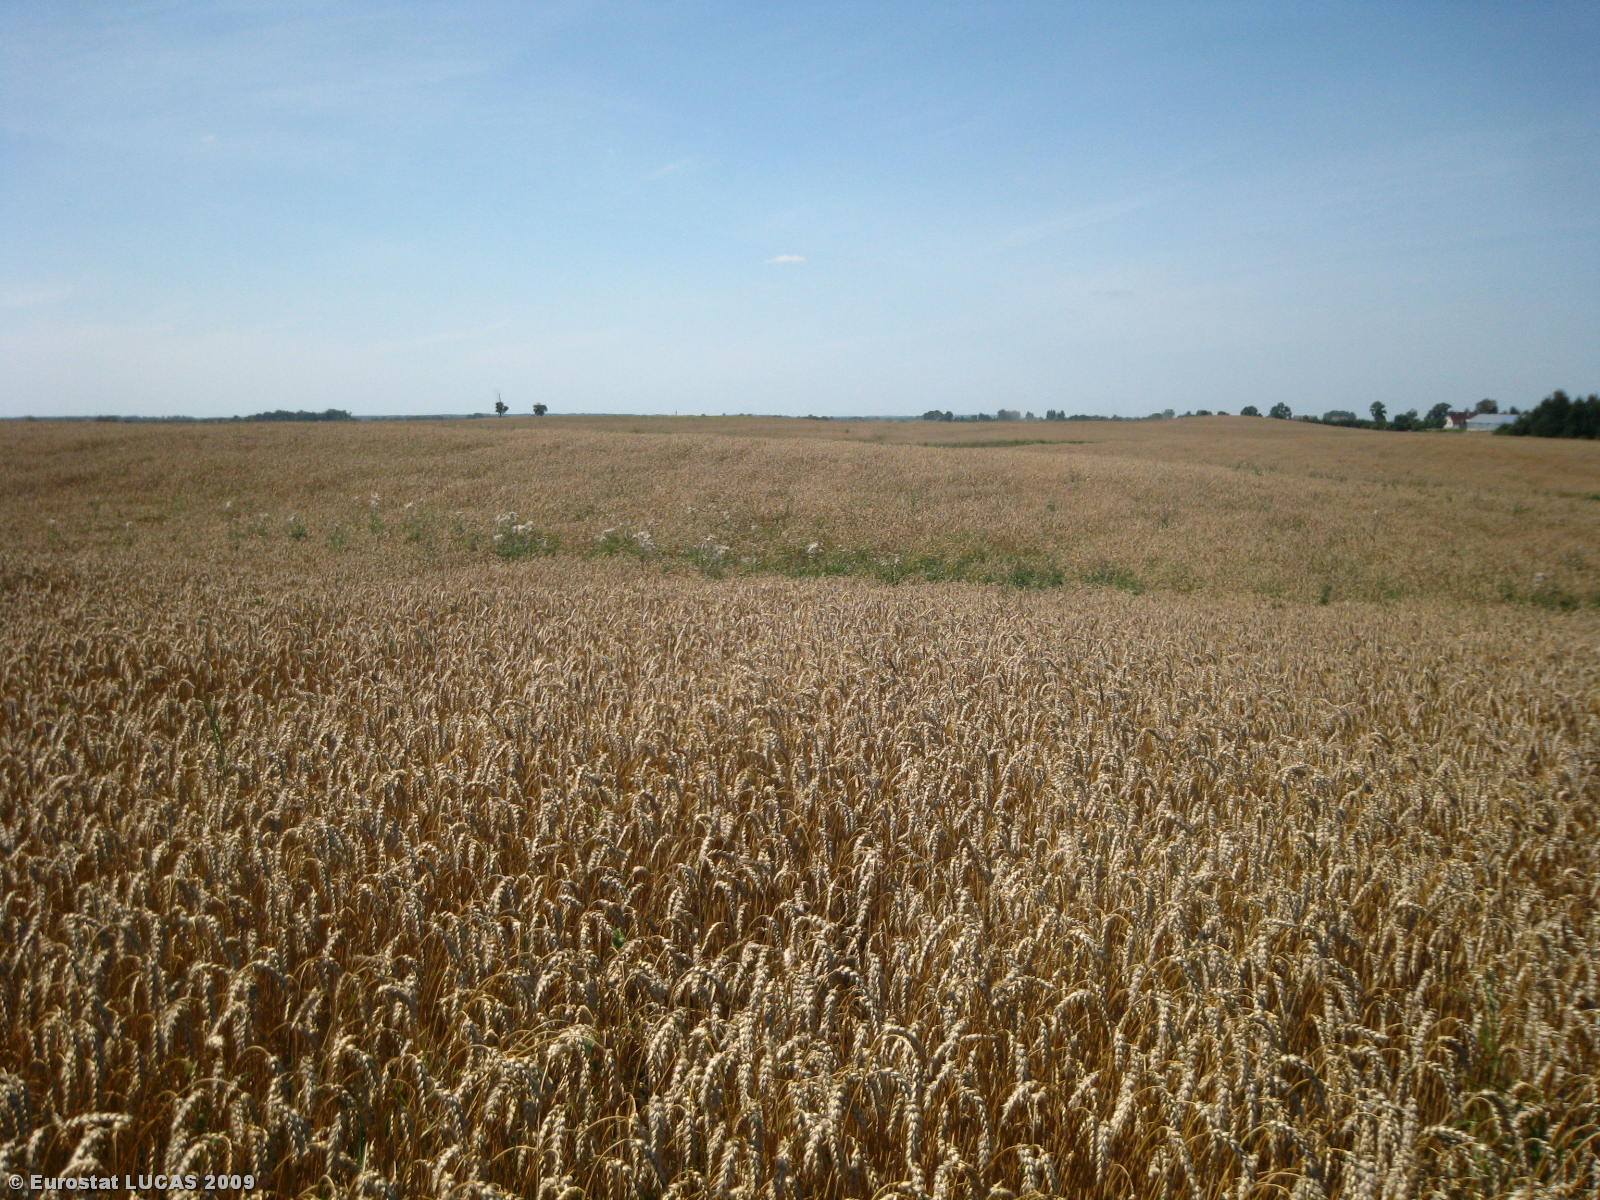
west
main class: Cropland
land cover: Common wheat
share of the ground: > 75 %
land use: Agriculture (excluding fallow land and kitchen gardens)
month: August
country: LT
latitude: 55.4663
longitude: 23.7017
